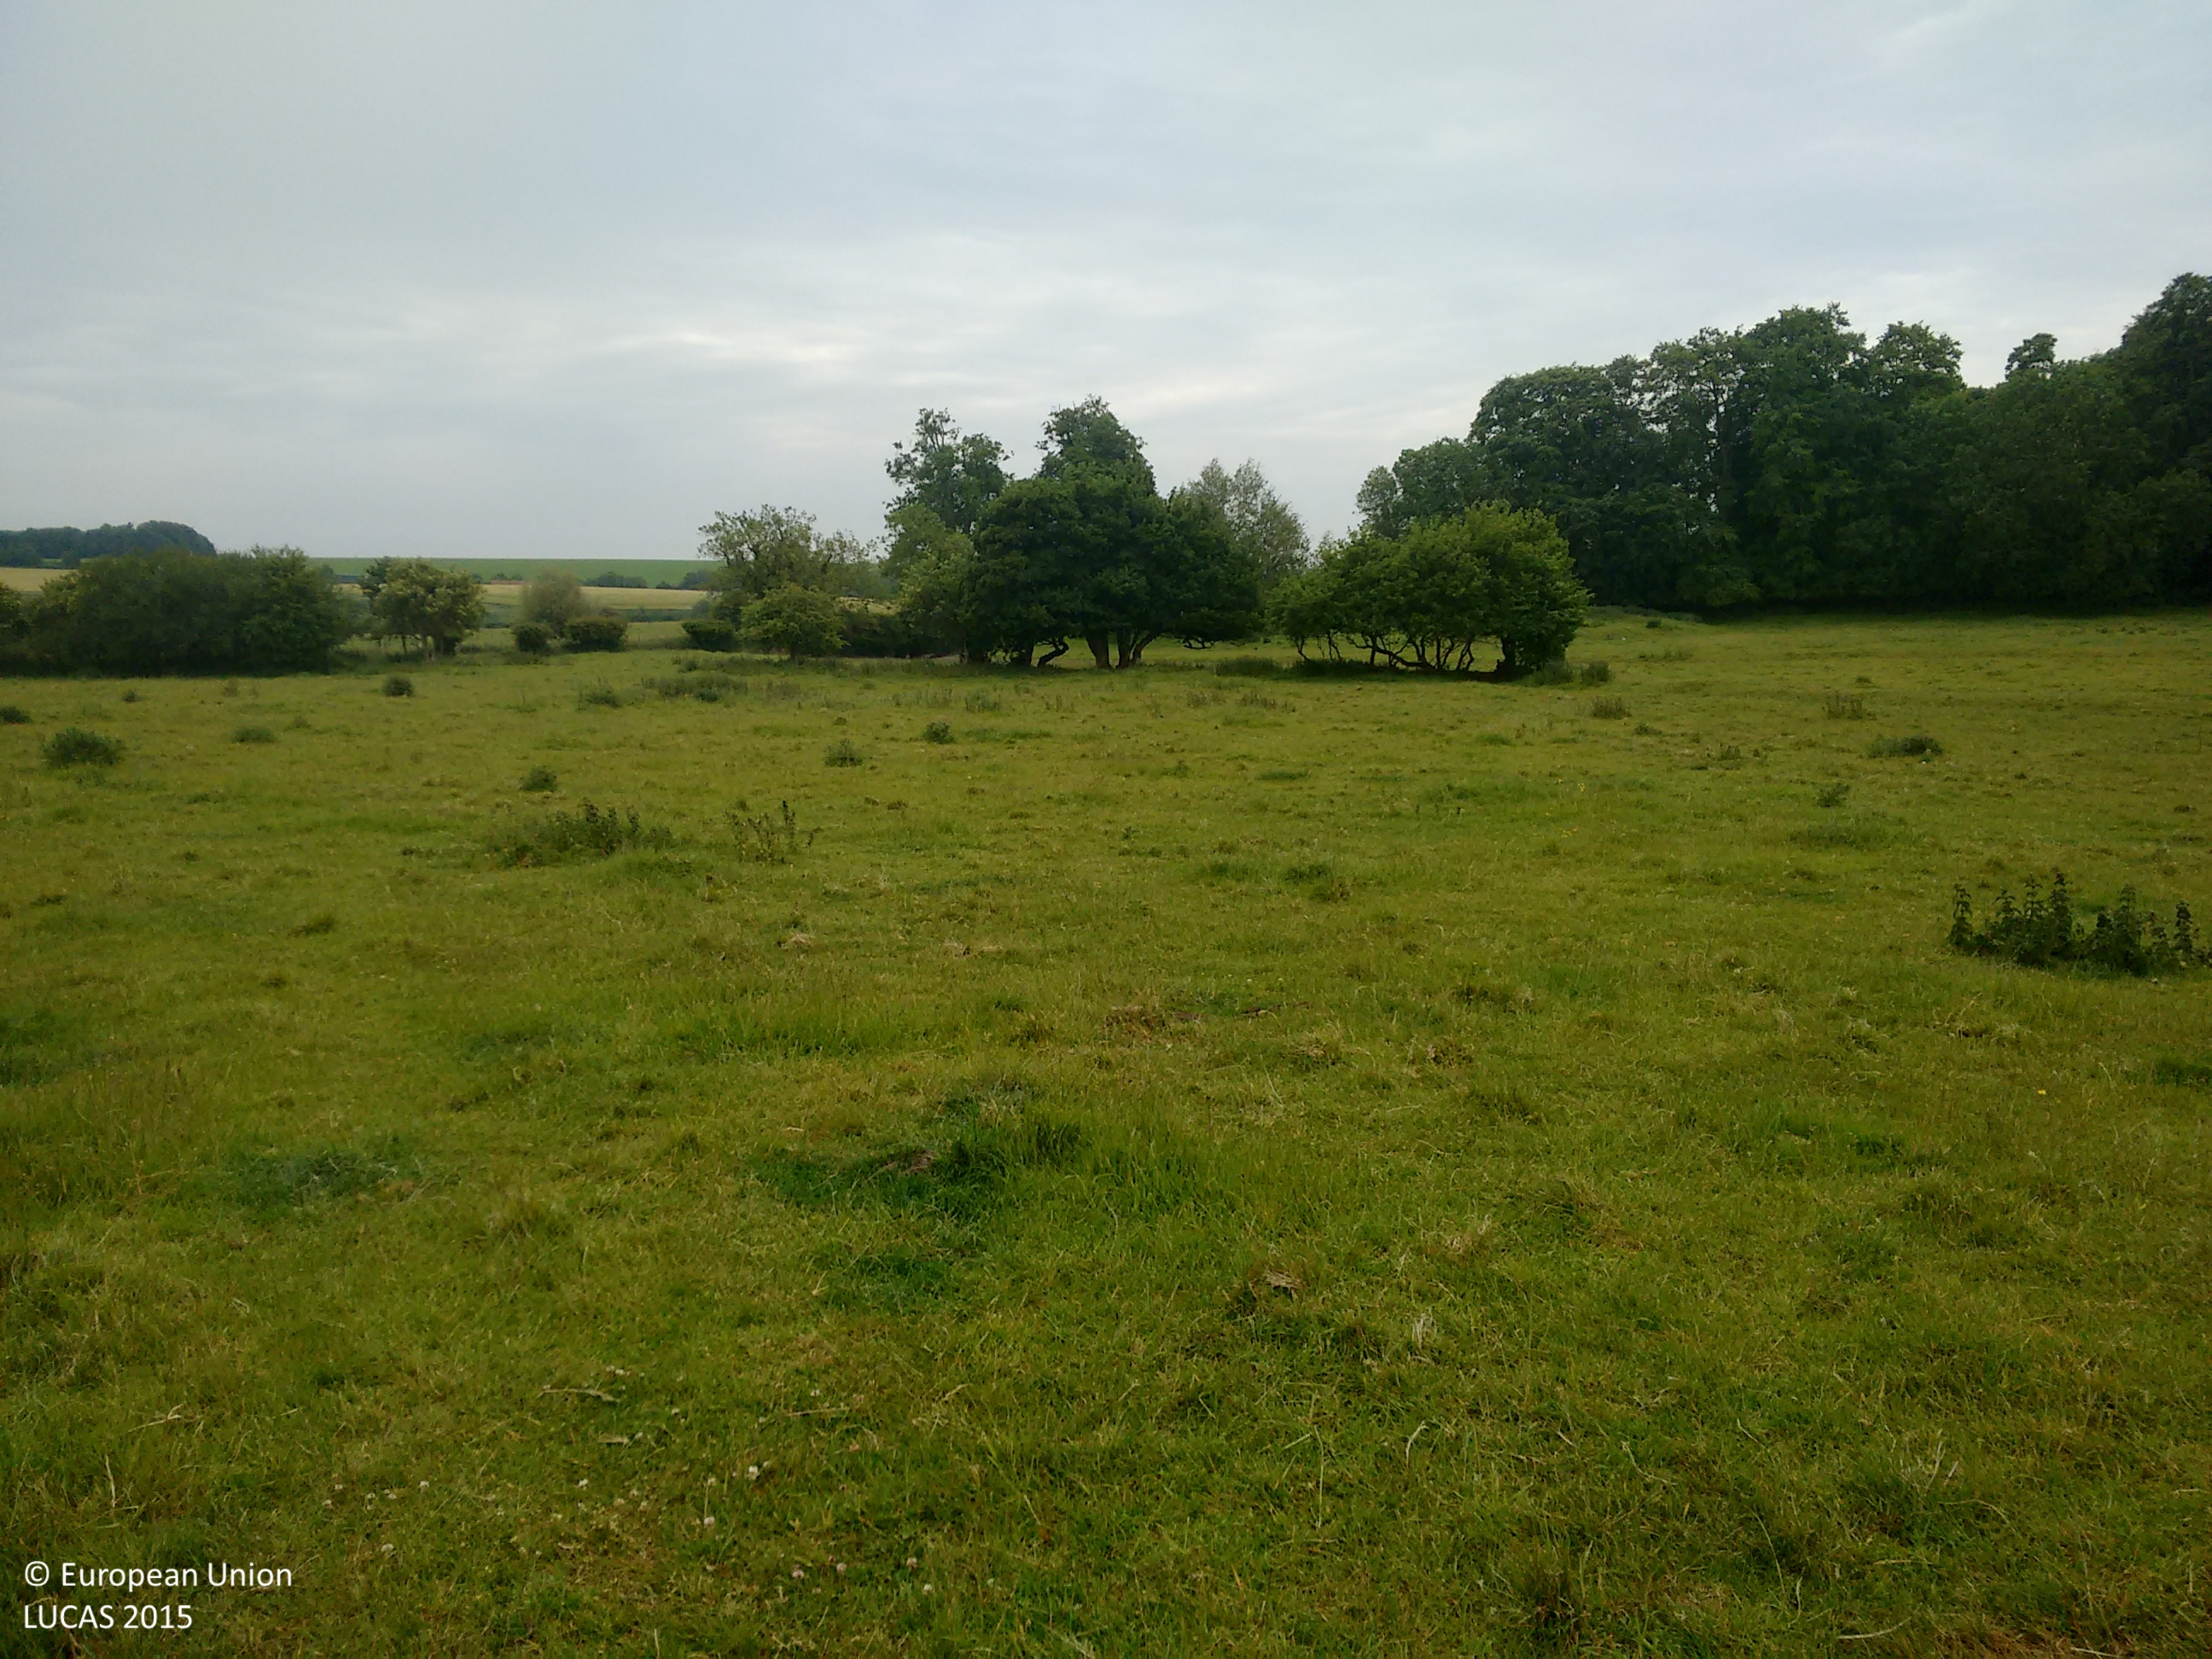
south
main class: Grassland
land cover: Grassland without tree/shrub cover
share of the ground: > 75 %
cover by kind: herbaceous plants 100 %
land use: Agriculture (excluding fallow land and kitchen gardens)
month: June
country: GB
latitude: 51.1778
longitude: -1.8866
